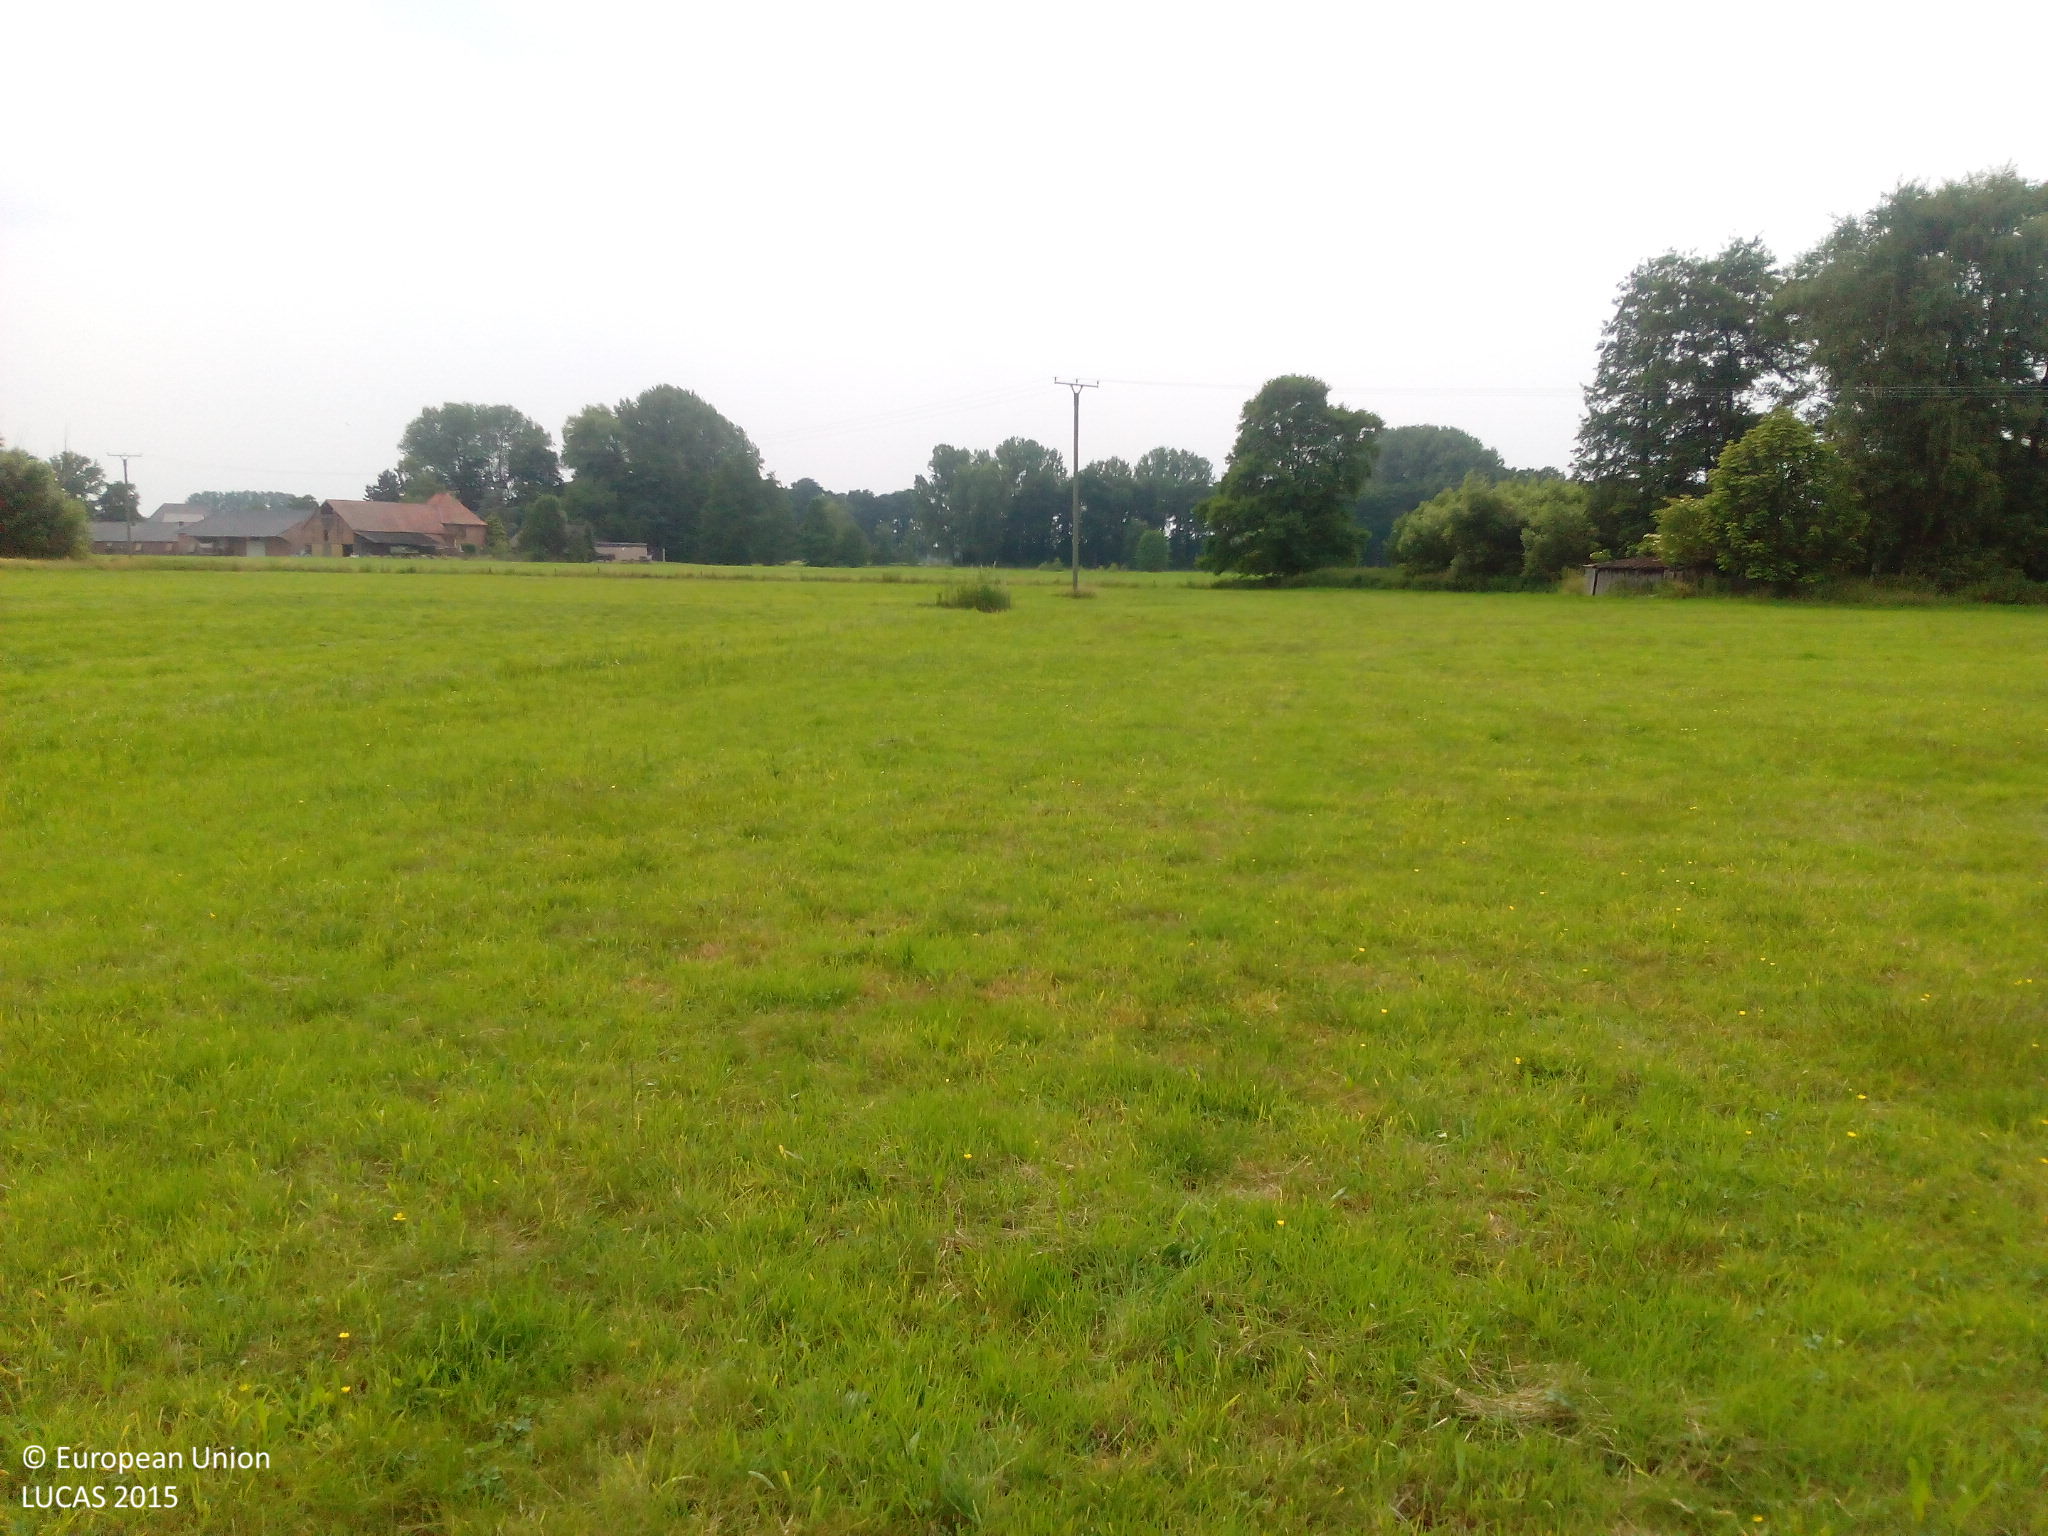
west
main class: Grassland
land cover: Grassland without tree/shrub cover
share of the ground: > 75 %
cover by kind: herbaceous plants 100 %
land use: Agriculture (excluding fallow land and kitchen gardens)
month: June
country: DE
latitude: 51.8104
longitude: 8.4774
